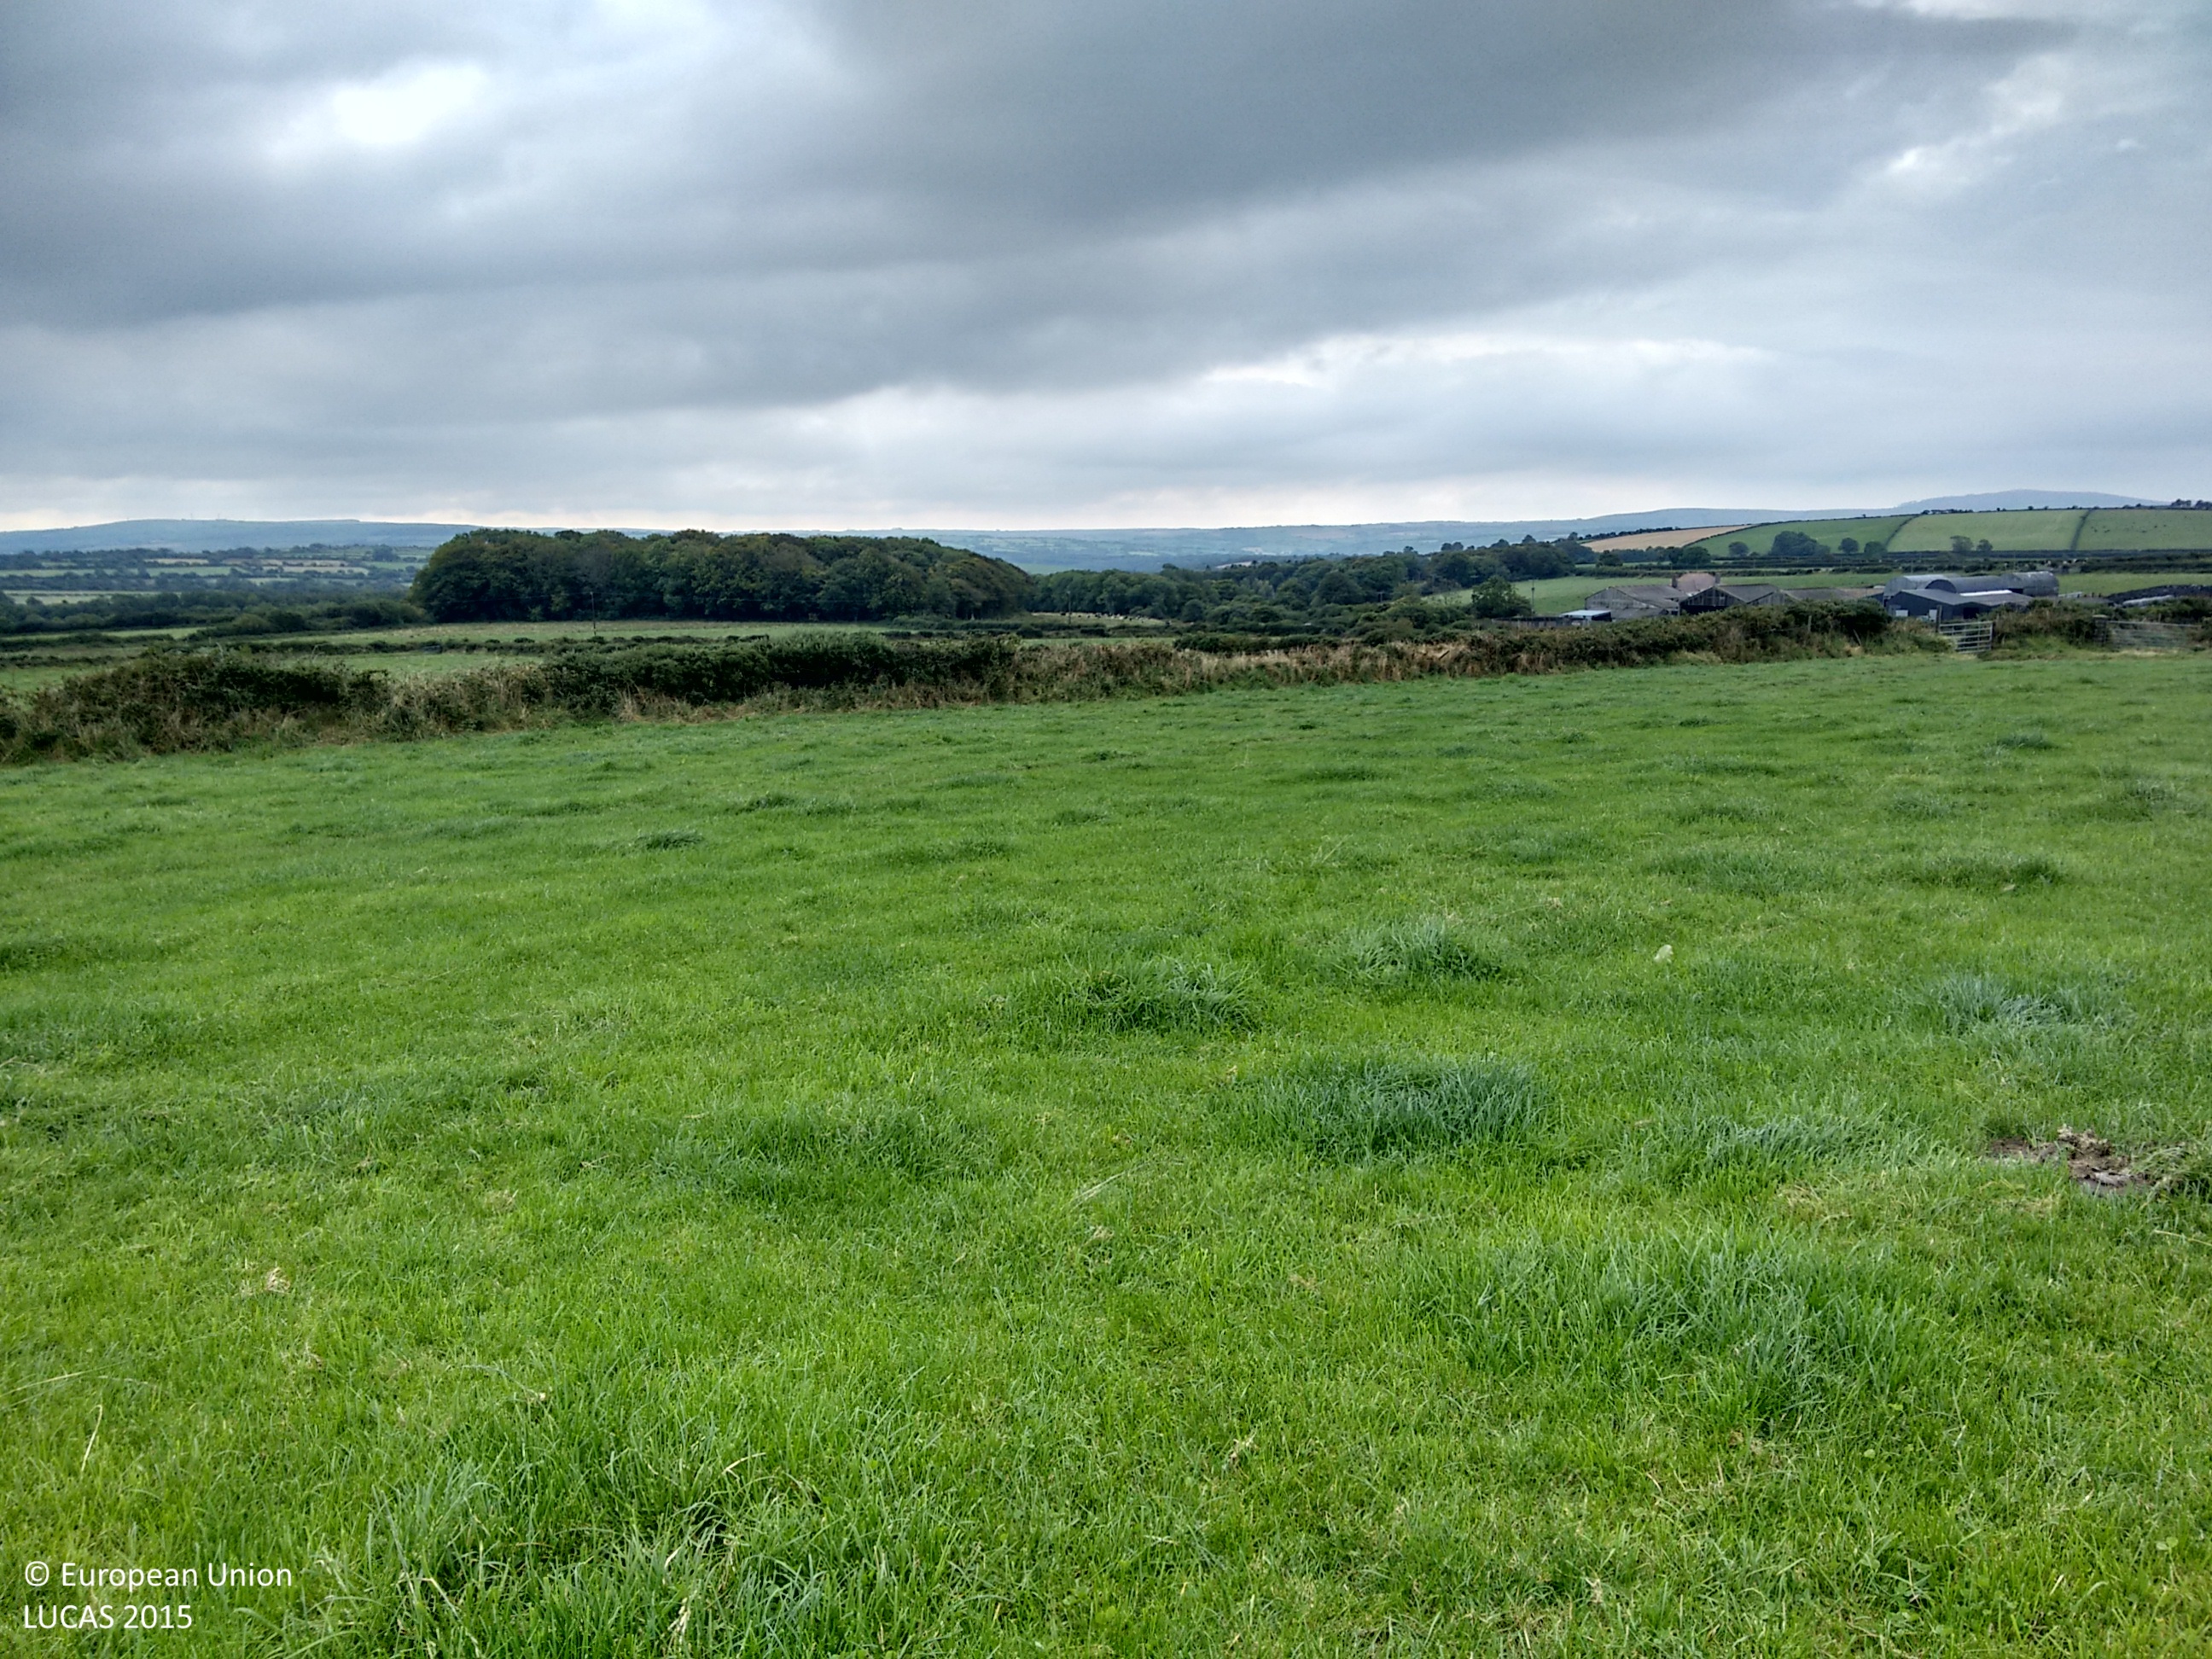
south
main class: Grassland
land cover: Grassland without tree/shrub cover
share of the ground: > 75 %
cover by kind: herbaceous plants 100 %
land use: Agriculture (excluding fallow land and kitchen gardens)
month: September
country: GB
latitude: 52.0969
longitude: -4.5433
